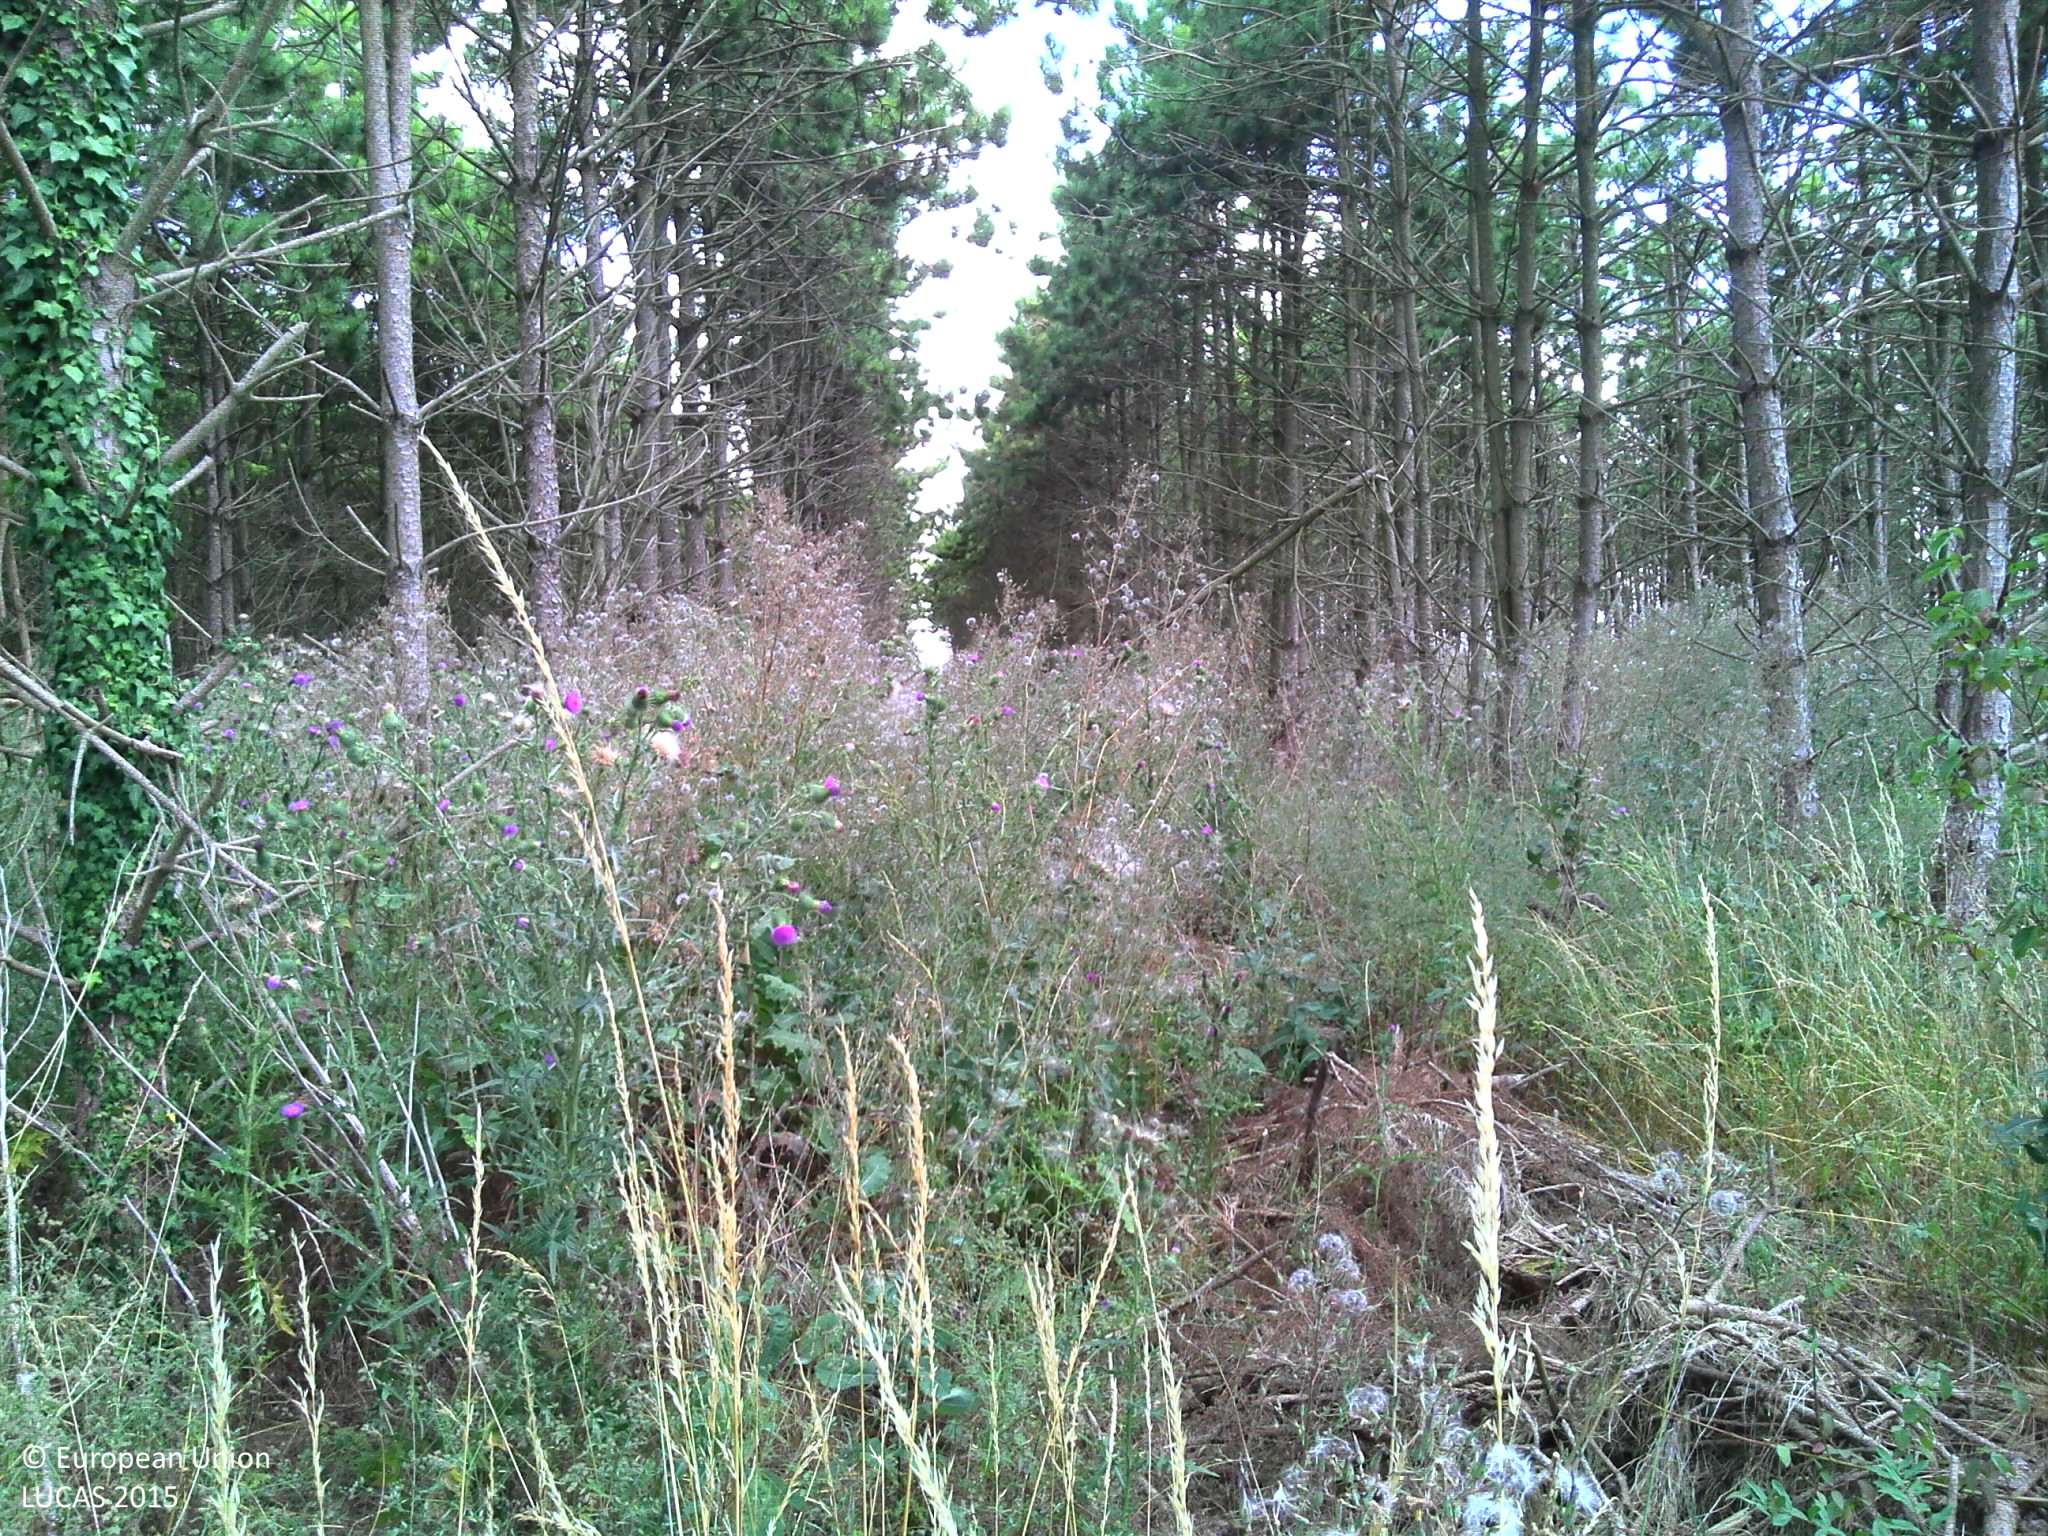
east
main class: Woodland
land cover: Pine dominated coniferous woodland
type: boreal forest
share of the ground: > 75 %
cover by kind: coniferous forest trees 60 %, herbaceous plants 30 %, lichens and mosses 5 %, unconsolidated bare surface 5 %
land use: Forestry
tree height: > 5 m
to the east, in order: Pine dominated coniferous woodland; Grass margins; Paved roads, cycling and walking lanes; Grass margins; Common wheat
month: July
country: FR
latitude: 49.3859
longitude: 4.1681
